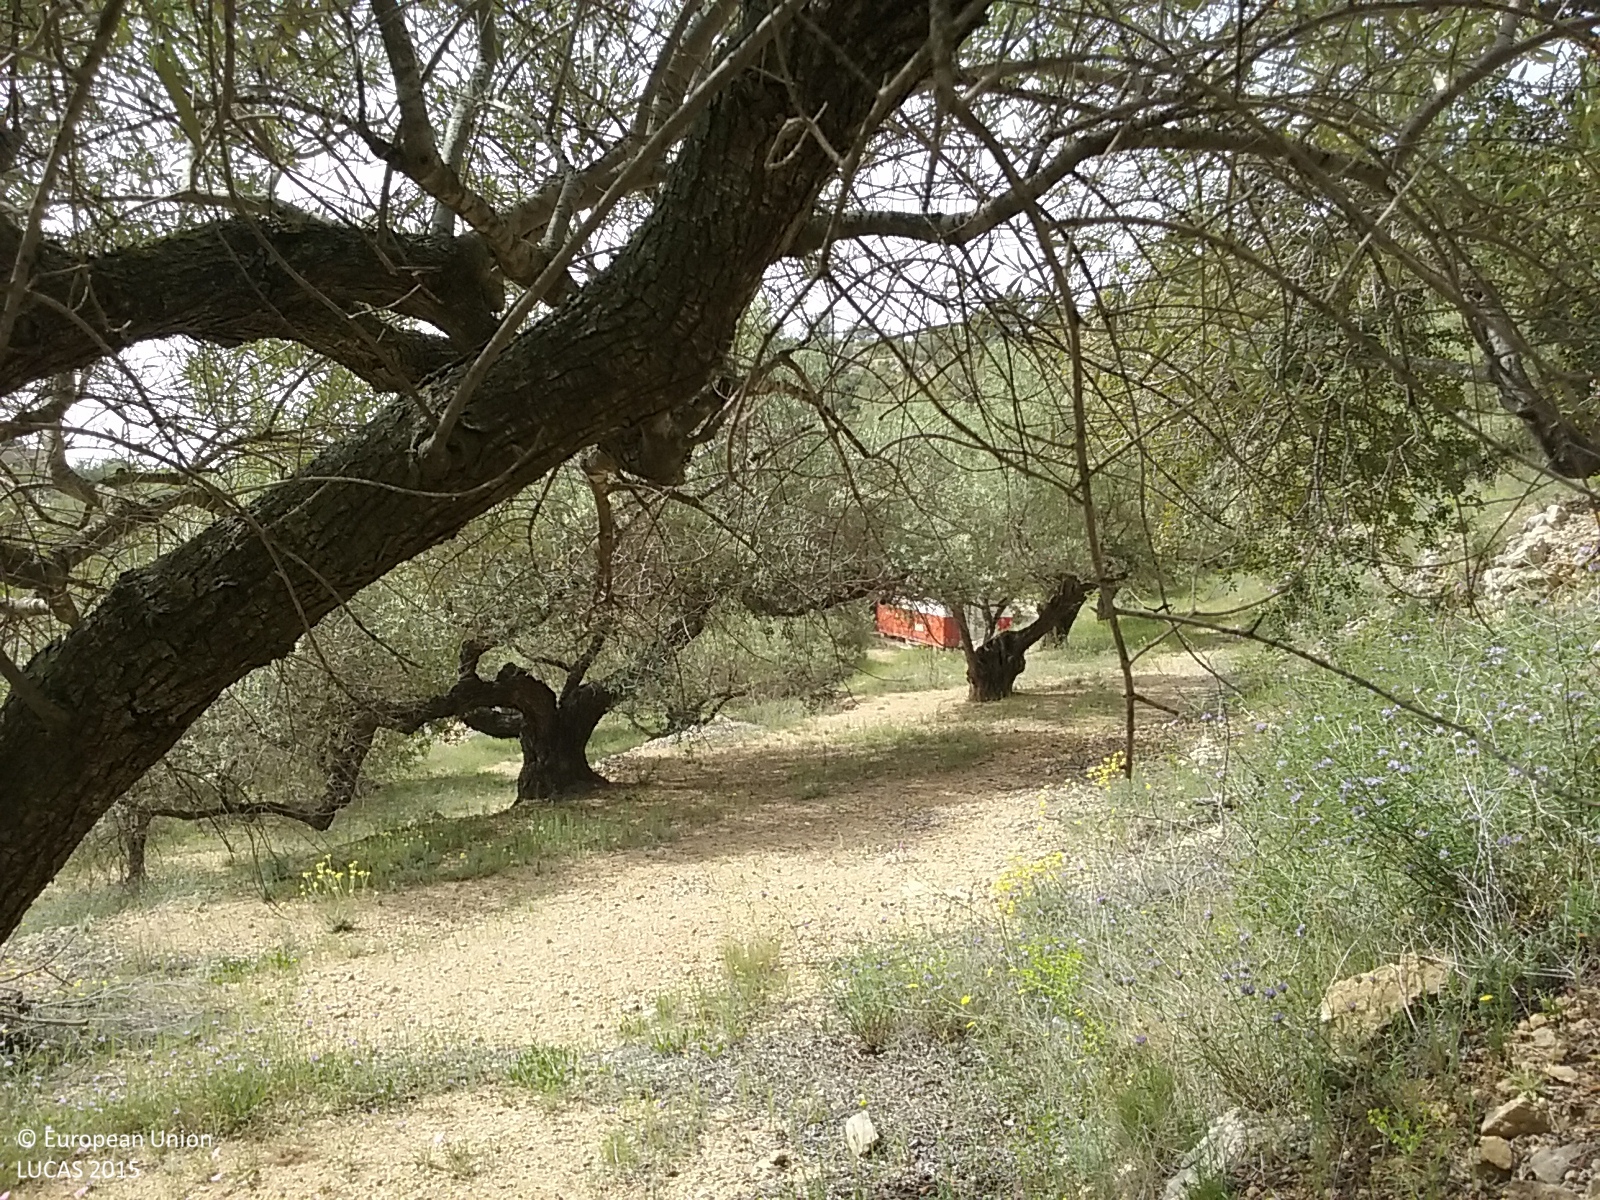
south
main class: Cropland
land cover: Olive groves
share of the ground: 50 - 75 %
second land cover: Spontaneously vegetated surfaces
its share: 50 - 75 %
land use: Agriculture (excluding fallow land and kitchen gardens)
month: May
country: ES
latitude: 40.7772
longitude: 0.5746
